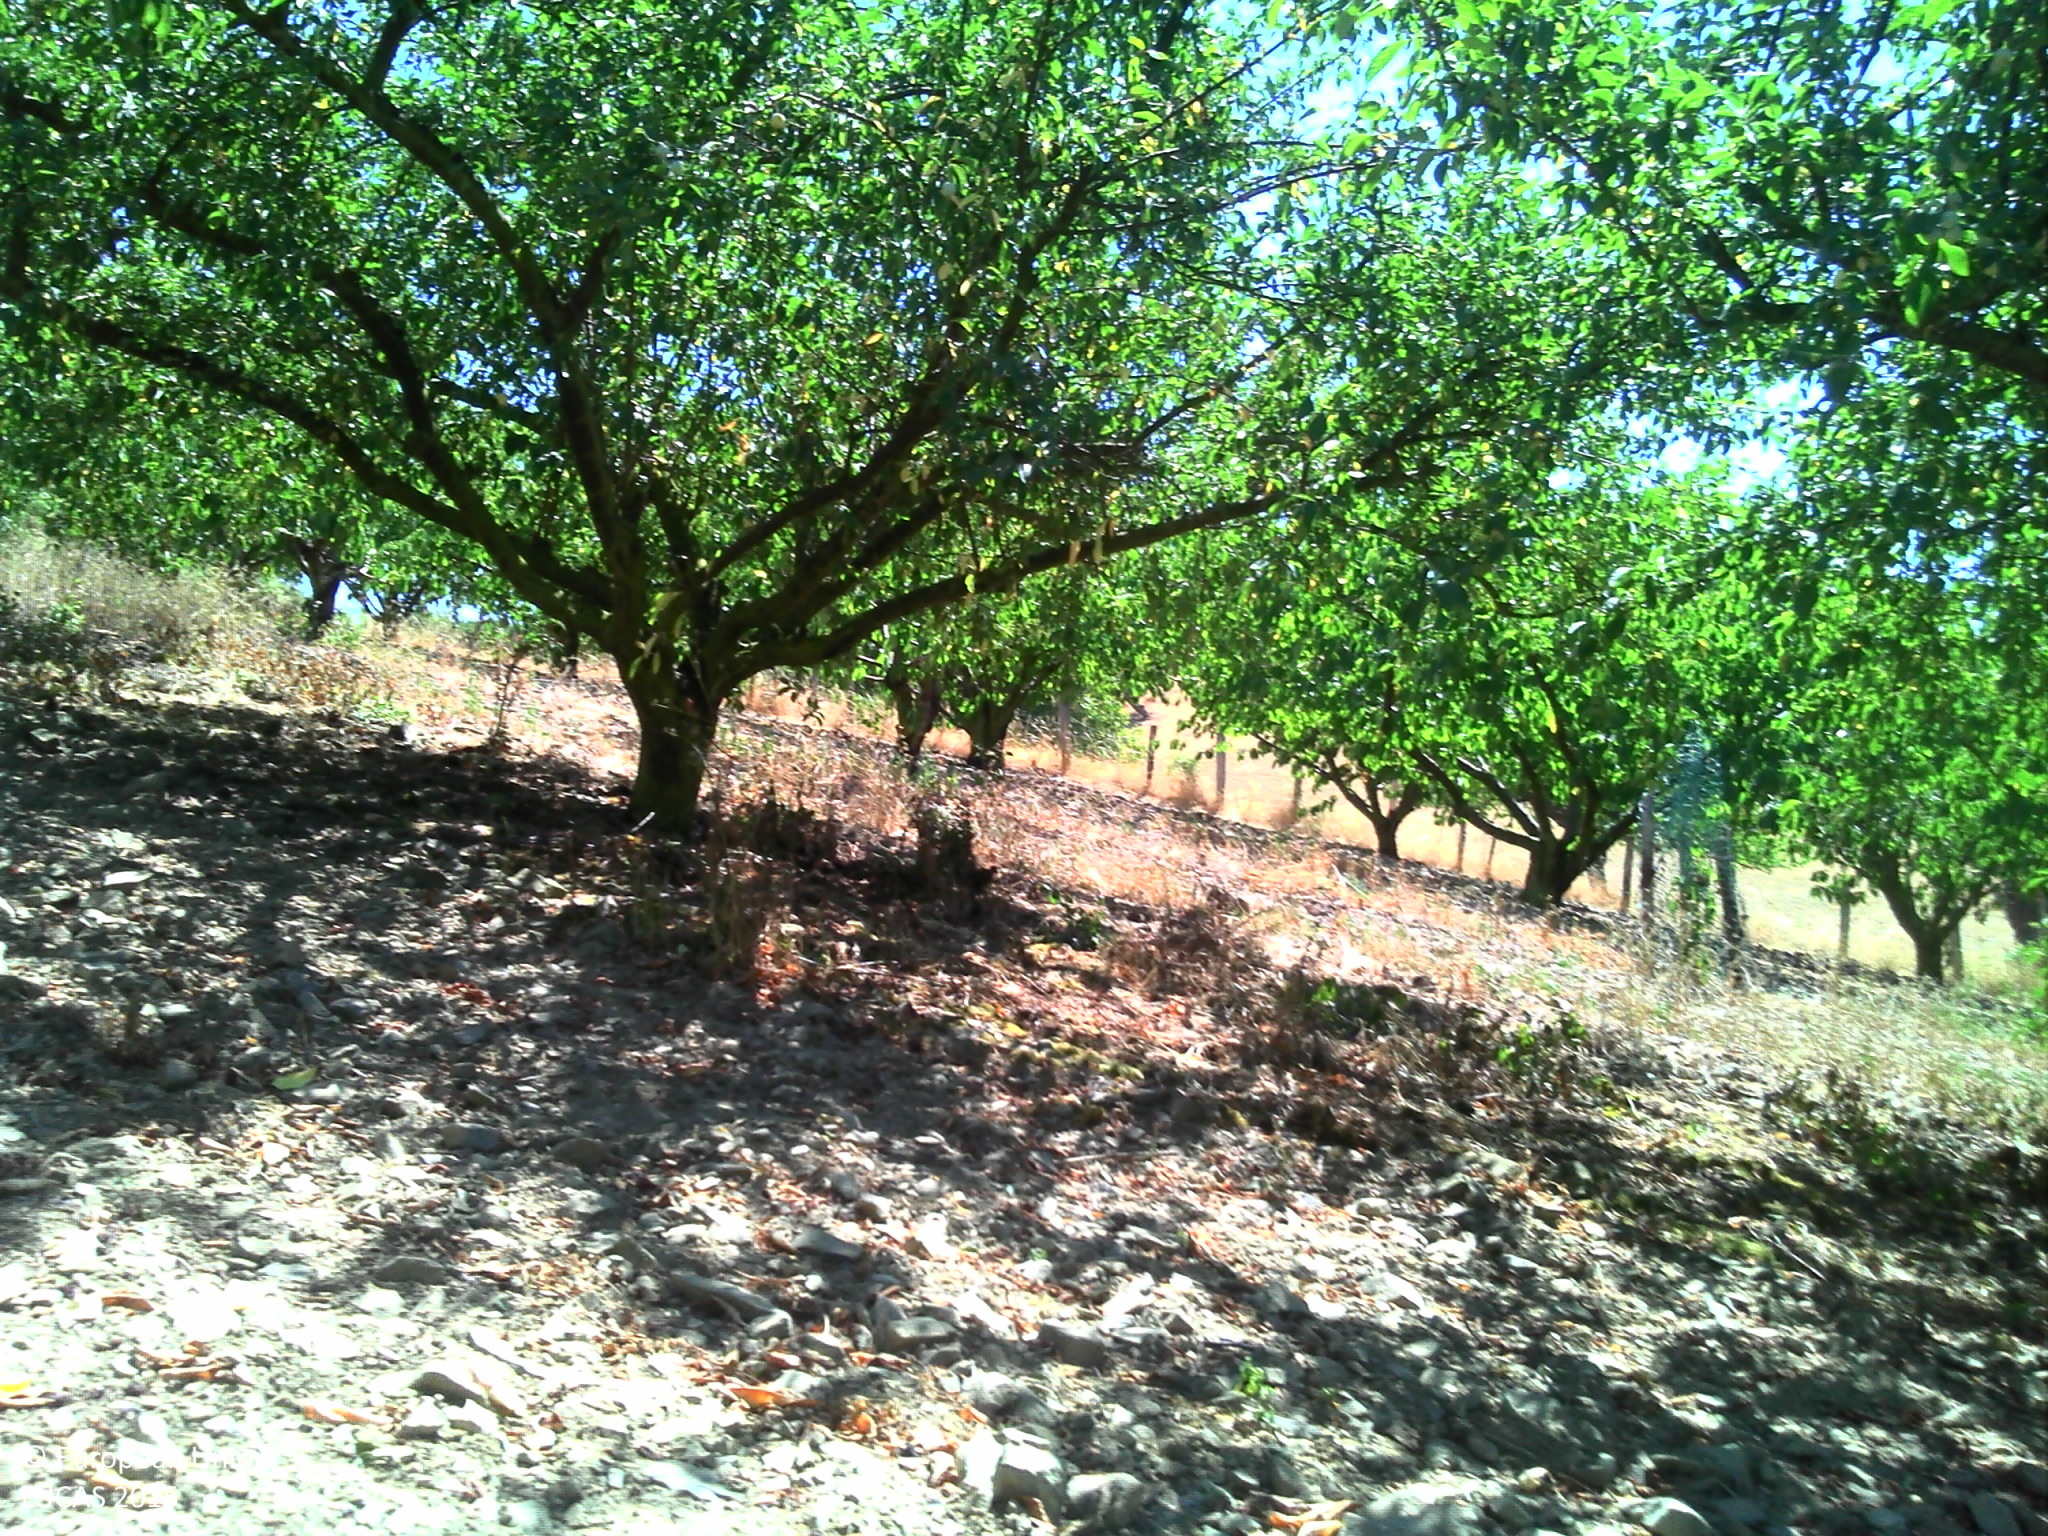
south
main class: Cropland
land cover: Cherry fruit
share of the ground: > 75 %
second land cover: Other fruit trees and berries
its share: < 10 %
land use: Agriculture (excluding fallow land and kitchen gardens)
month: July
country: FR
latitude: 45.8335
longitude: 4.5574
